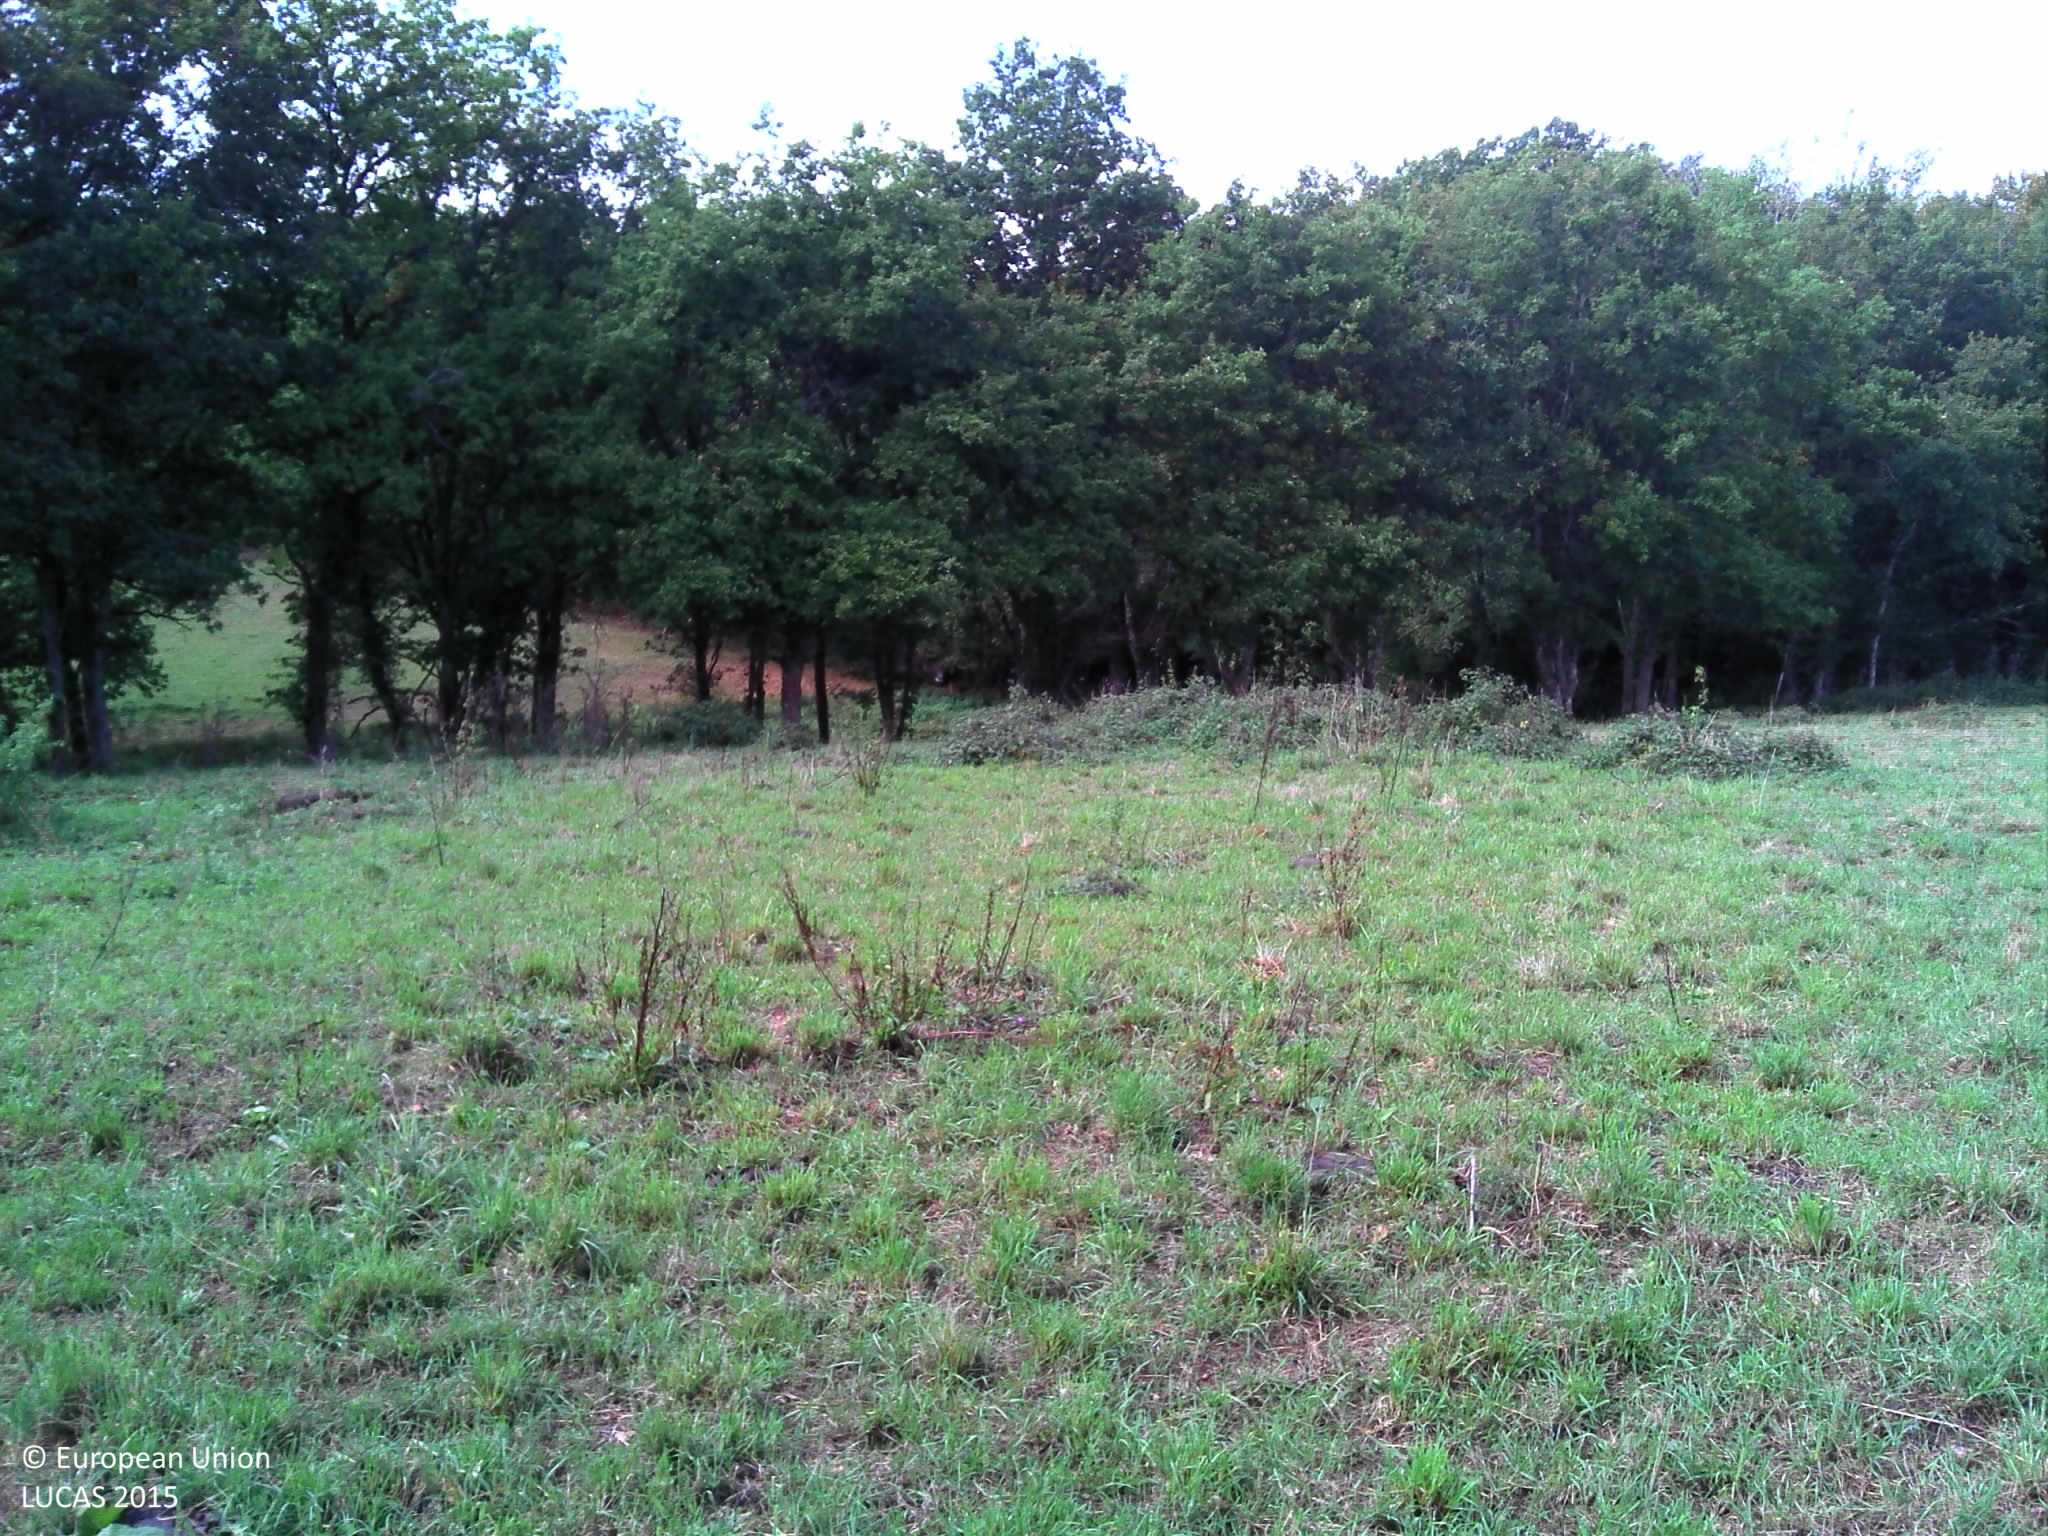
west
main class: Grassland
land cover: Grassland without tree/shrub cover
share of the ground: > 75 %
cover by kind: herbaceous plants 100 %
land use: Agriculture (excluding fallow land and kitchen gardens)
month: September
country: FR
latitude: 46.4445
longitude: 1.6993
